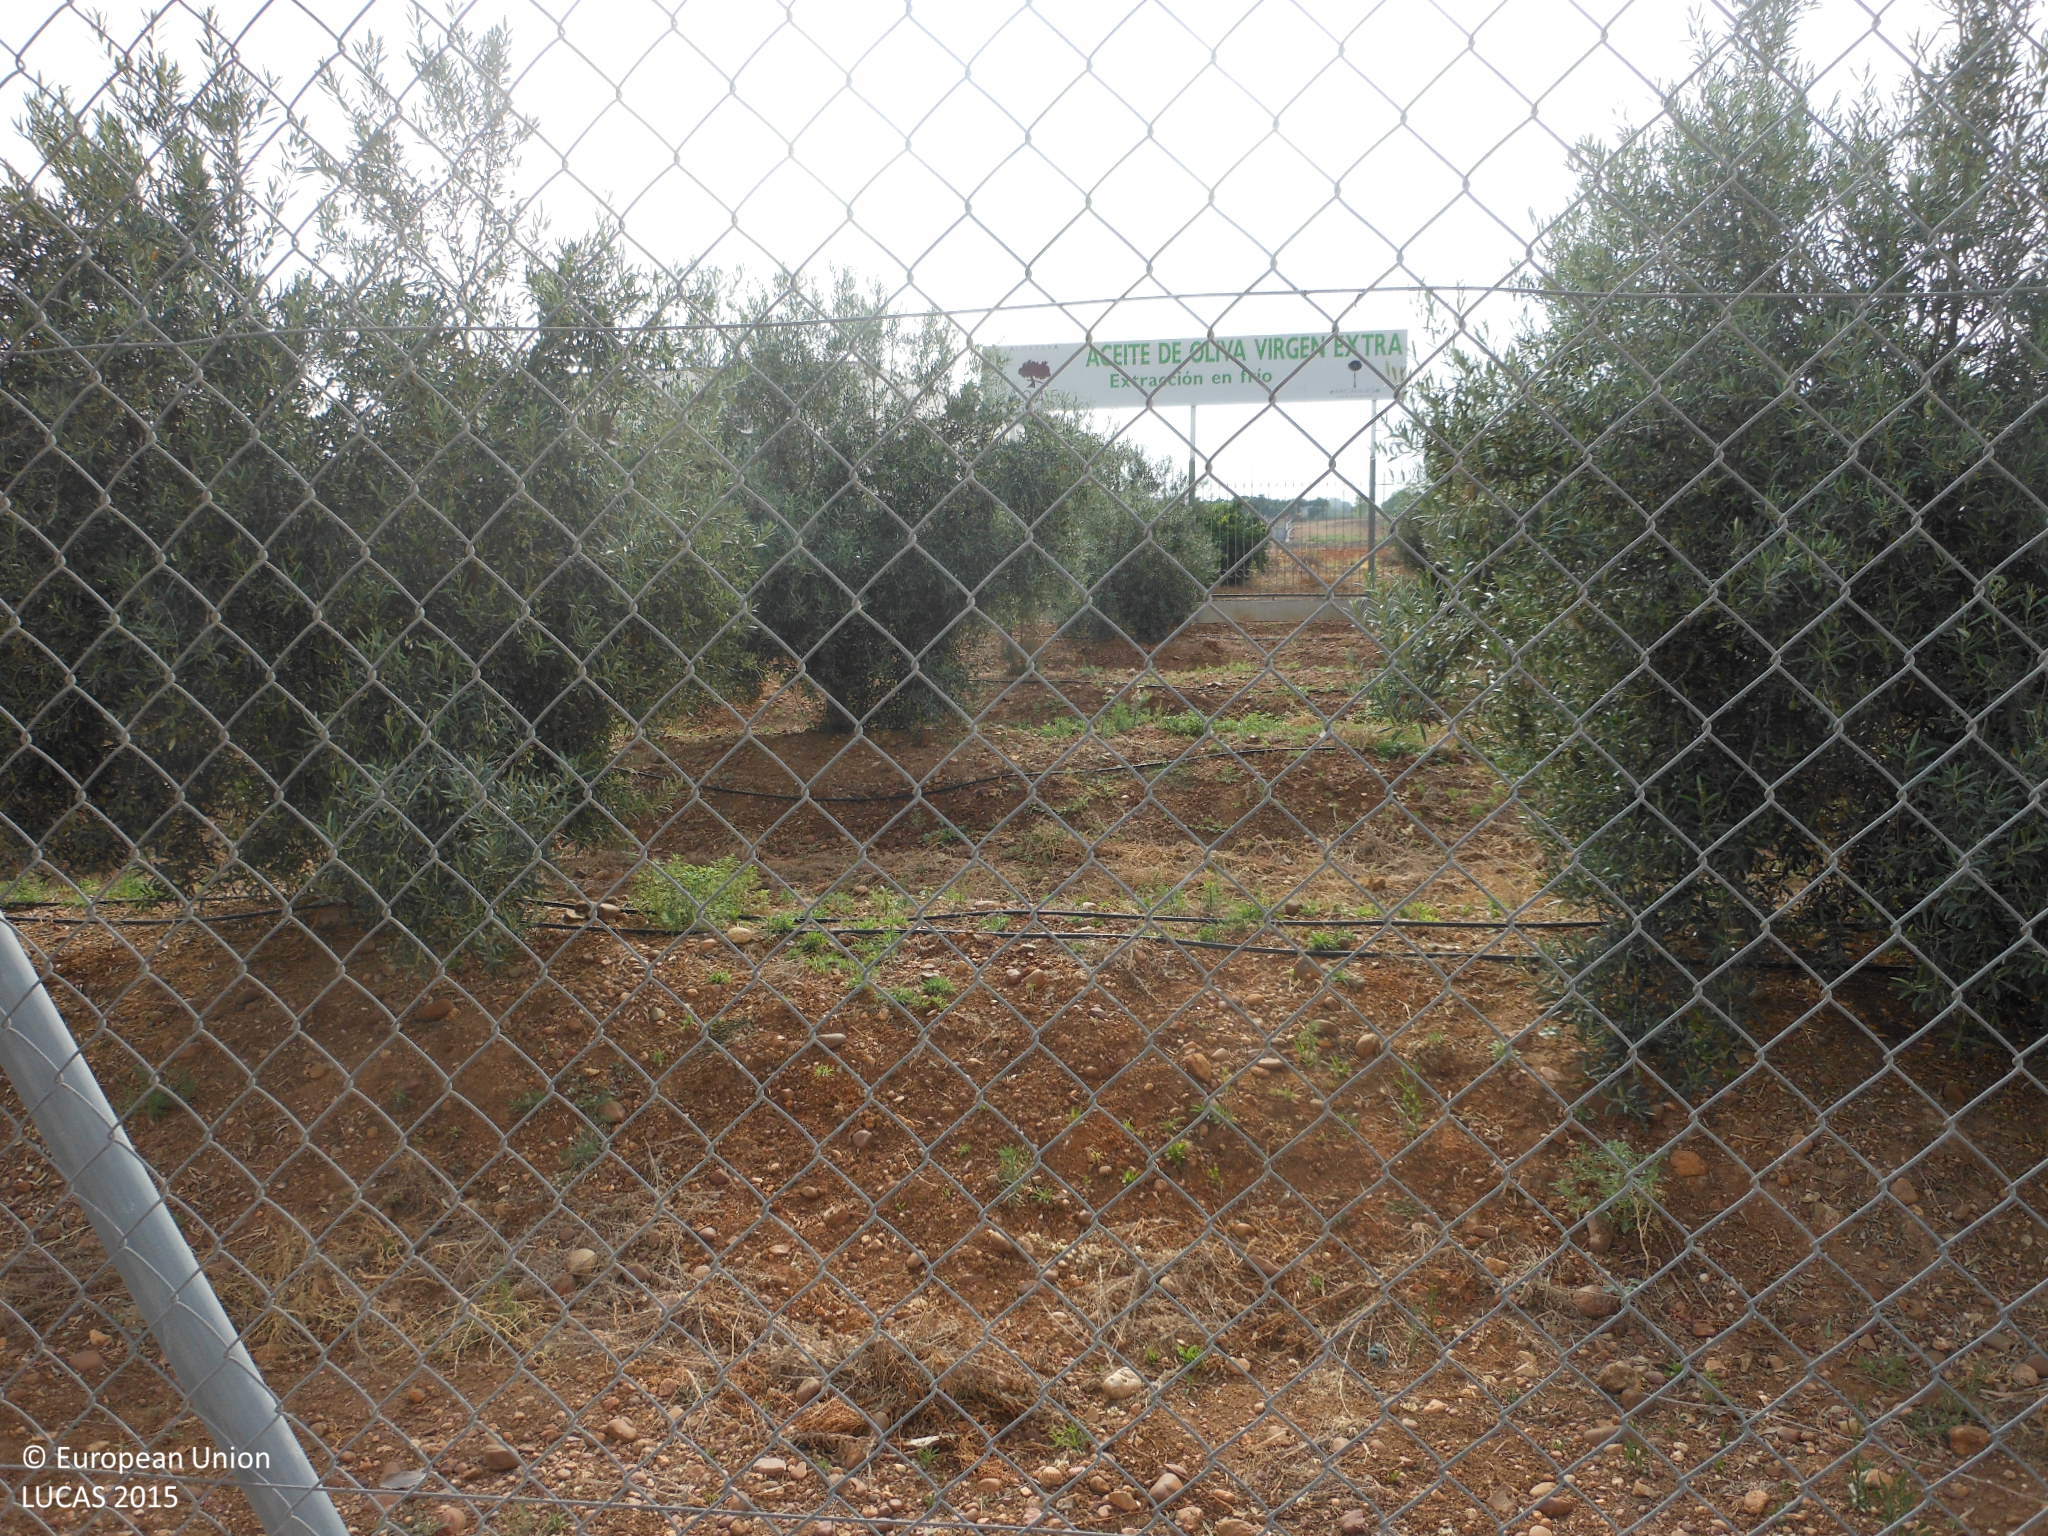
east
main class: Cropland
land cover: Olive groves
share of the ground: 50 - 75 %
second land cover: Other bare soil
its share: > 75 %
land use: Agriculture (excluding fallow land and kitchen gardens)
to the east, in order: Olive groves; Other bare soil; Arable land (only in case pi); Artificial constructions in urban areas; Lines of trees; Arable land (only in case pi)
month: June
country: ES
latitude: 37.6246
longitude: -4.9572
